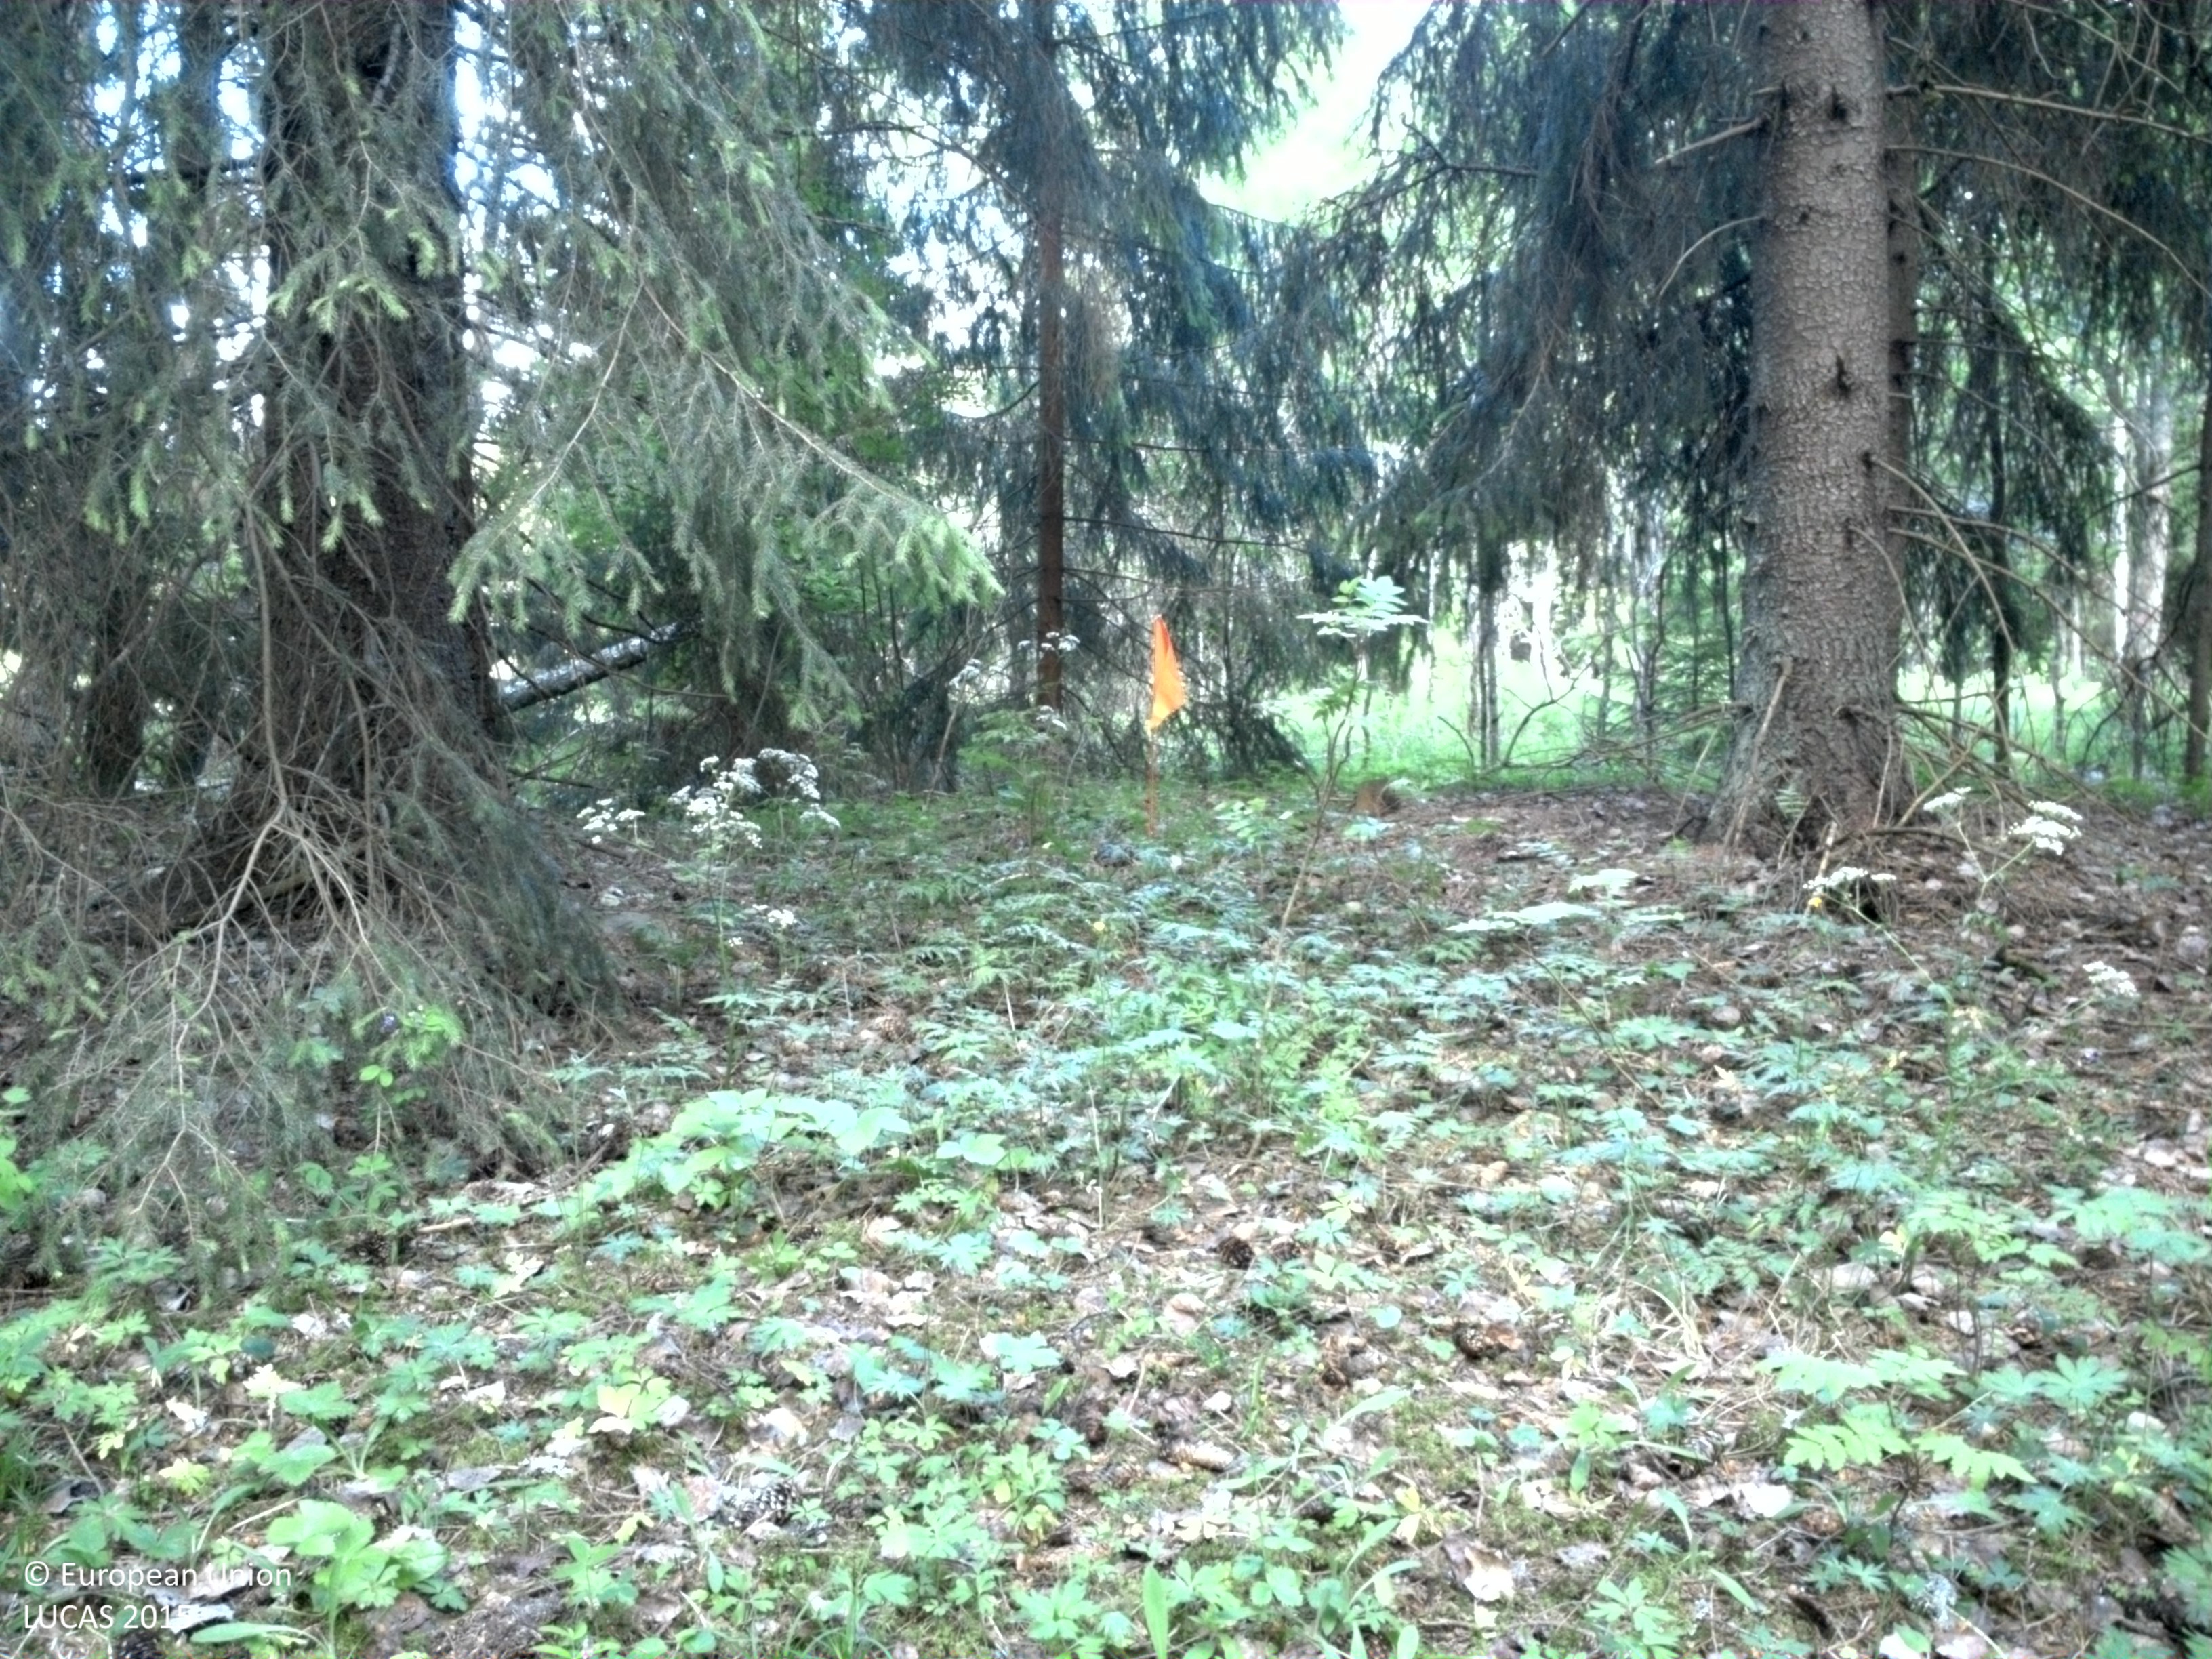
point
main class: Woodland
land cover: Spruce dominated coniferous woodland
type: boreal forest
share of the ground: > 75 %
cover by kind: coniferous forest trees 80 %, broadleaved forest trees 10 %, herbaceous plants 10 %
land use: Forestry
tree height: > 5 m
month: June
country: SE
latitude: 60.1802
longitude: 17.1485
